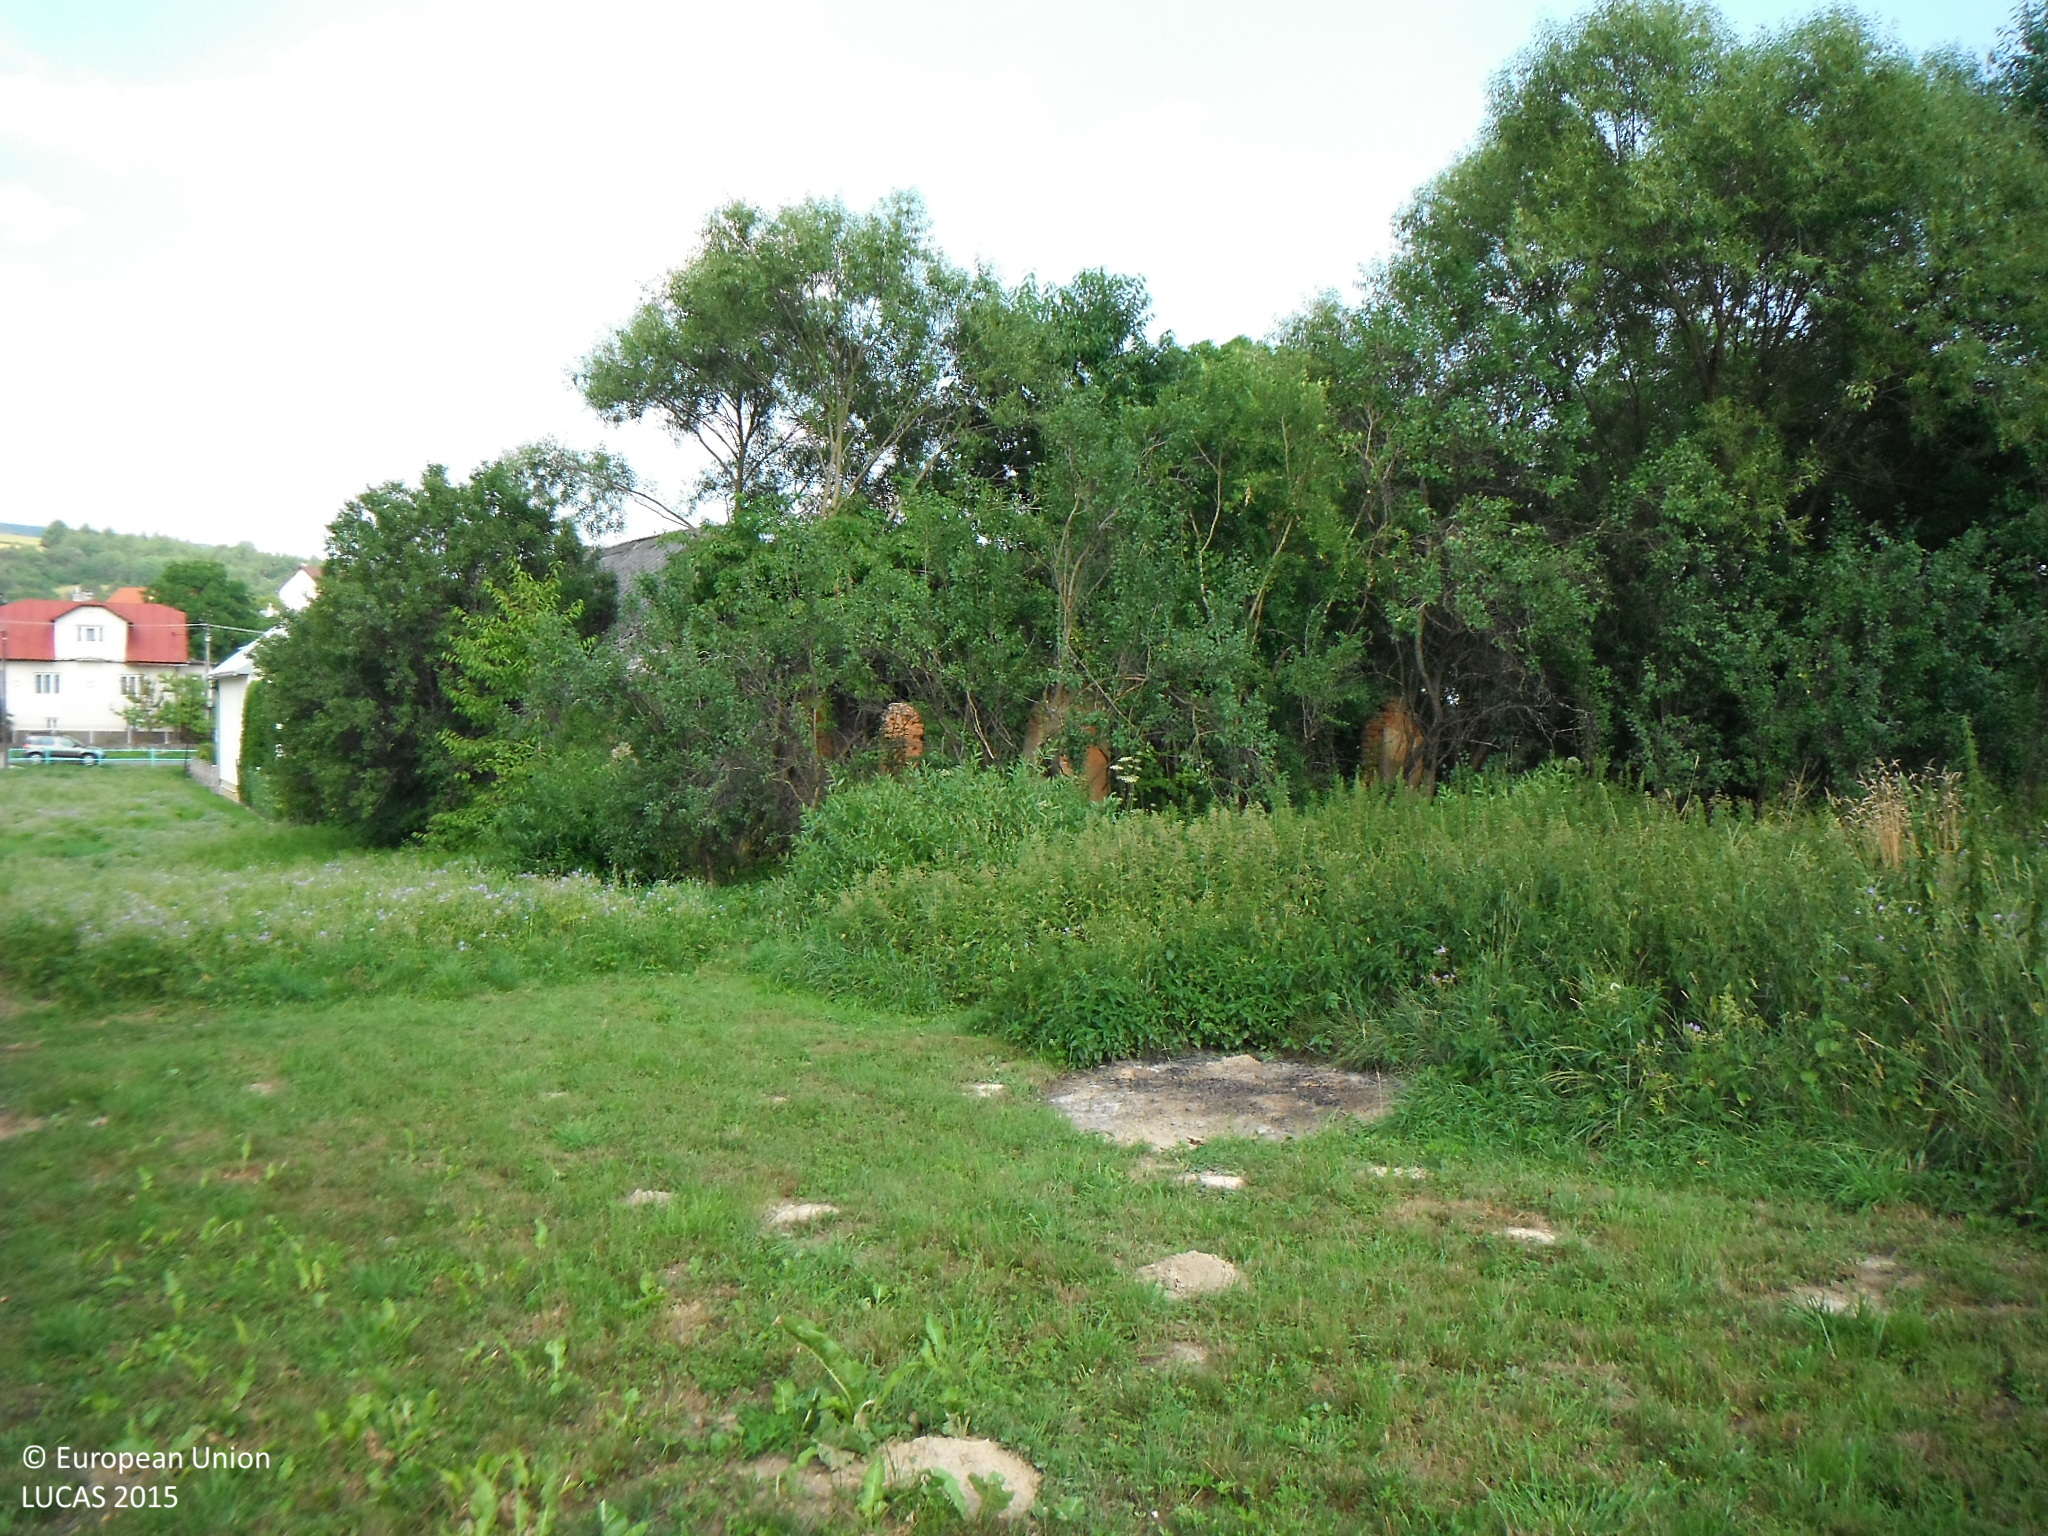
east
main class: Cropland
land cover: Apple fruit
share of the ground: 25 - 50 %
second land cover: Grassland without tree/shrub cover
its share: 50 - 75 %
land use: Kitchen garden
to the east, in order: Apple fruit; Grassland without tree/shrub cover; Artificial constructions in urban areas
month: July
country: SK
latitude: 49.2994
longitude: 21.4206
